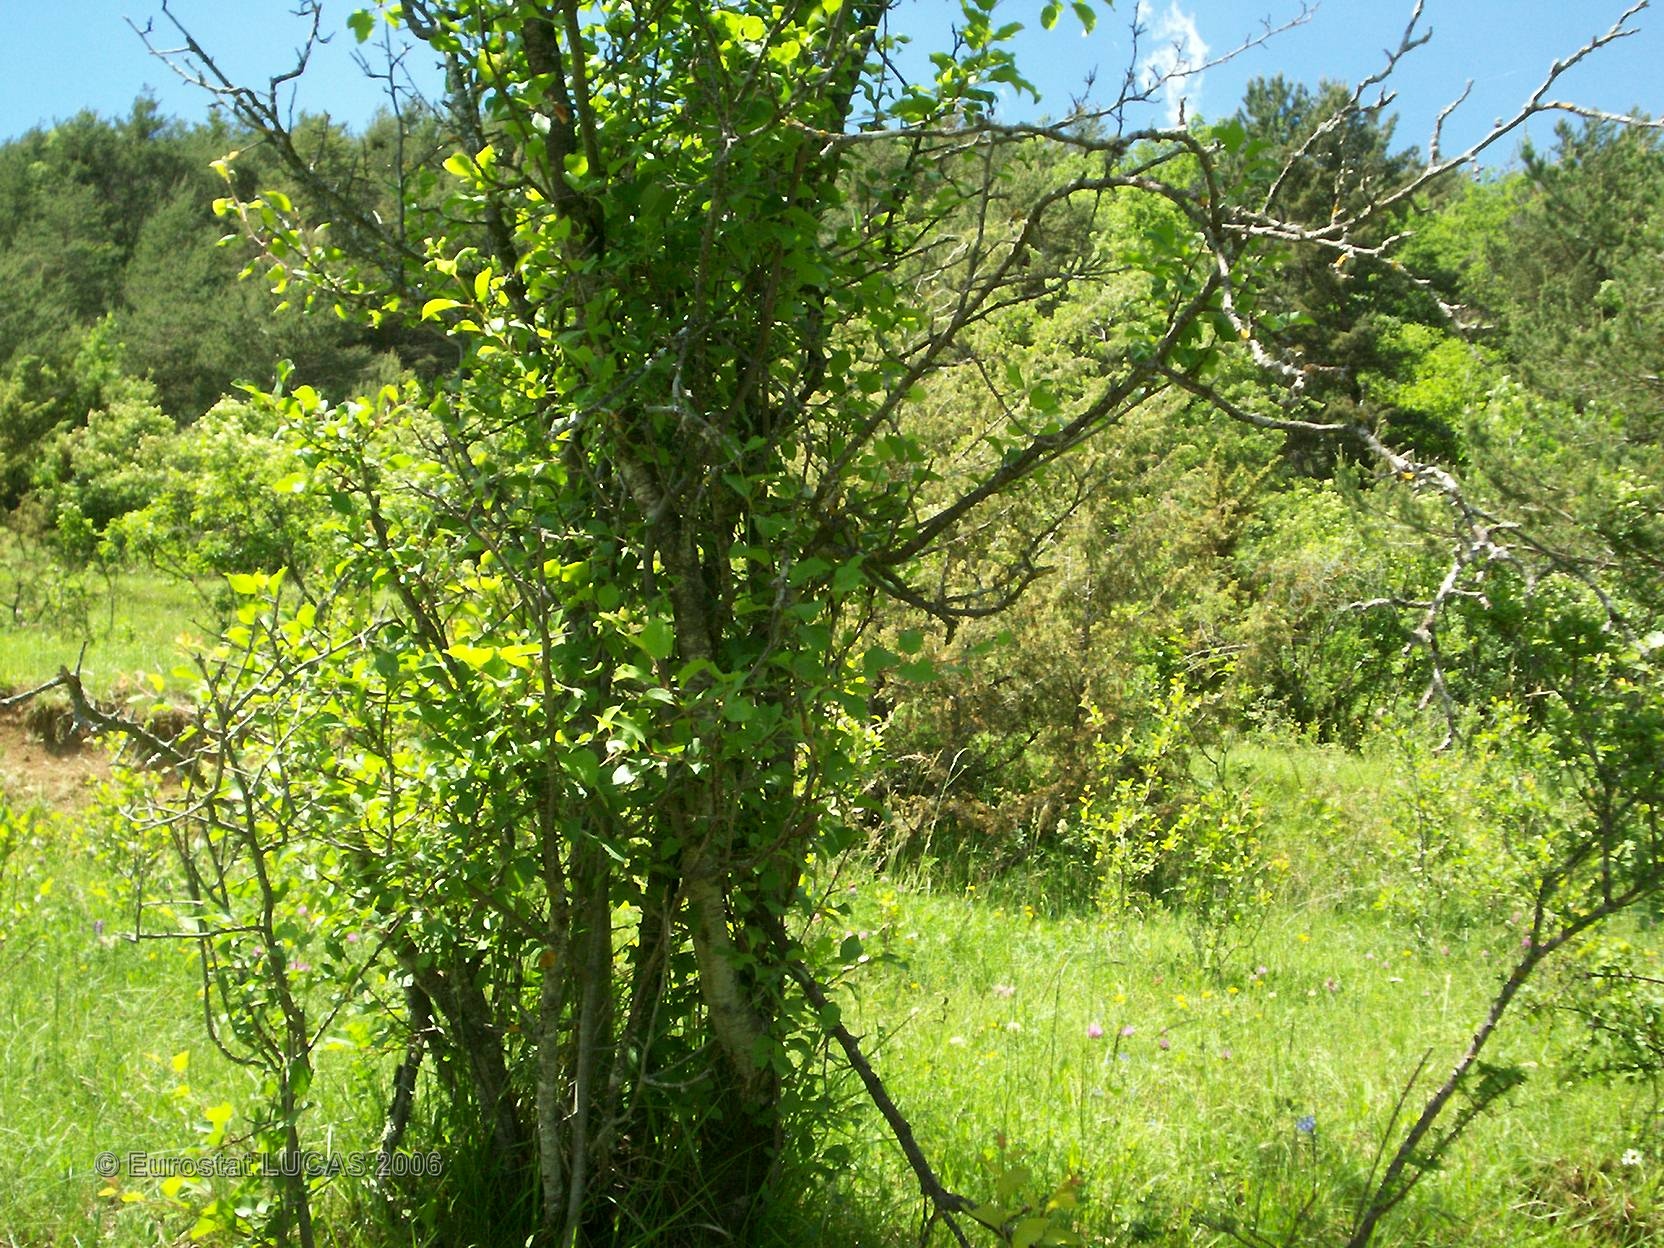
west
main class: Grassland
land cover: Grassland with sparse tree/shrub cover
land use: Agriculture (excluding fallow land and kitchen gardens)
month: May
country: FR
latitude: 44.0086
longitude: 7.2996
